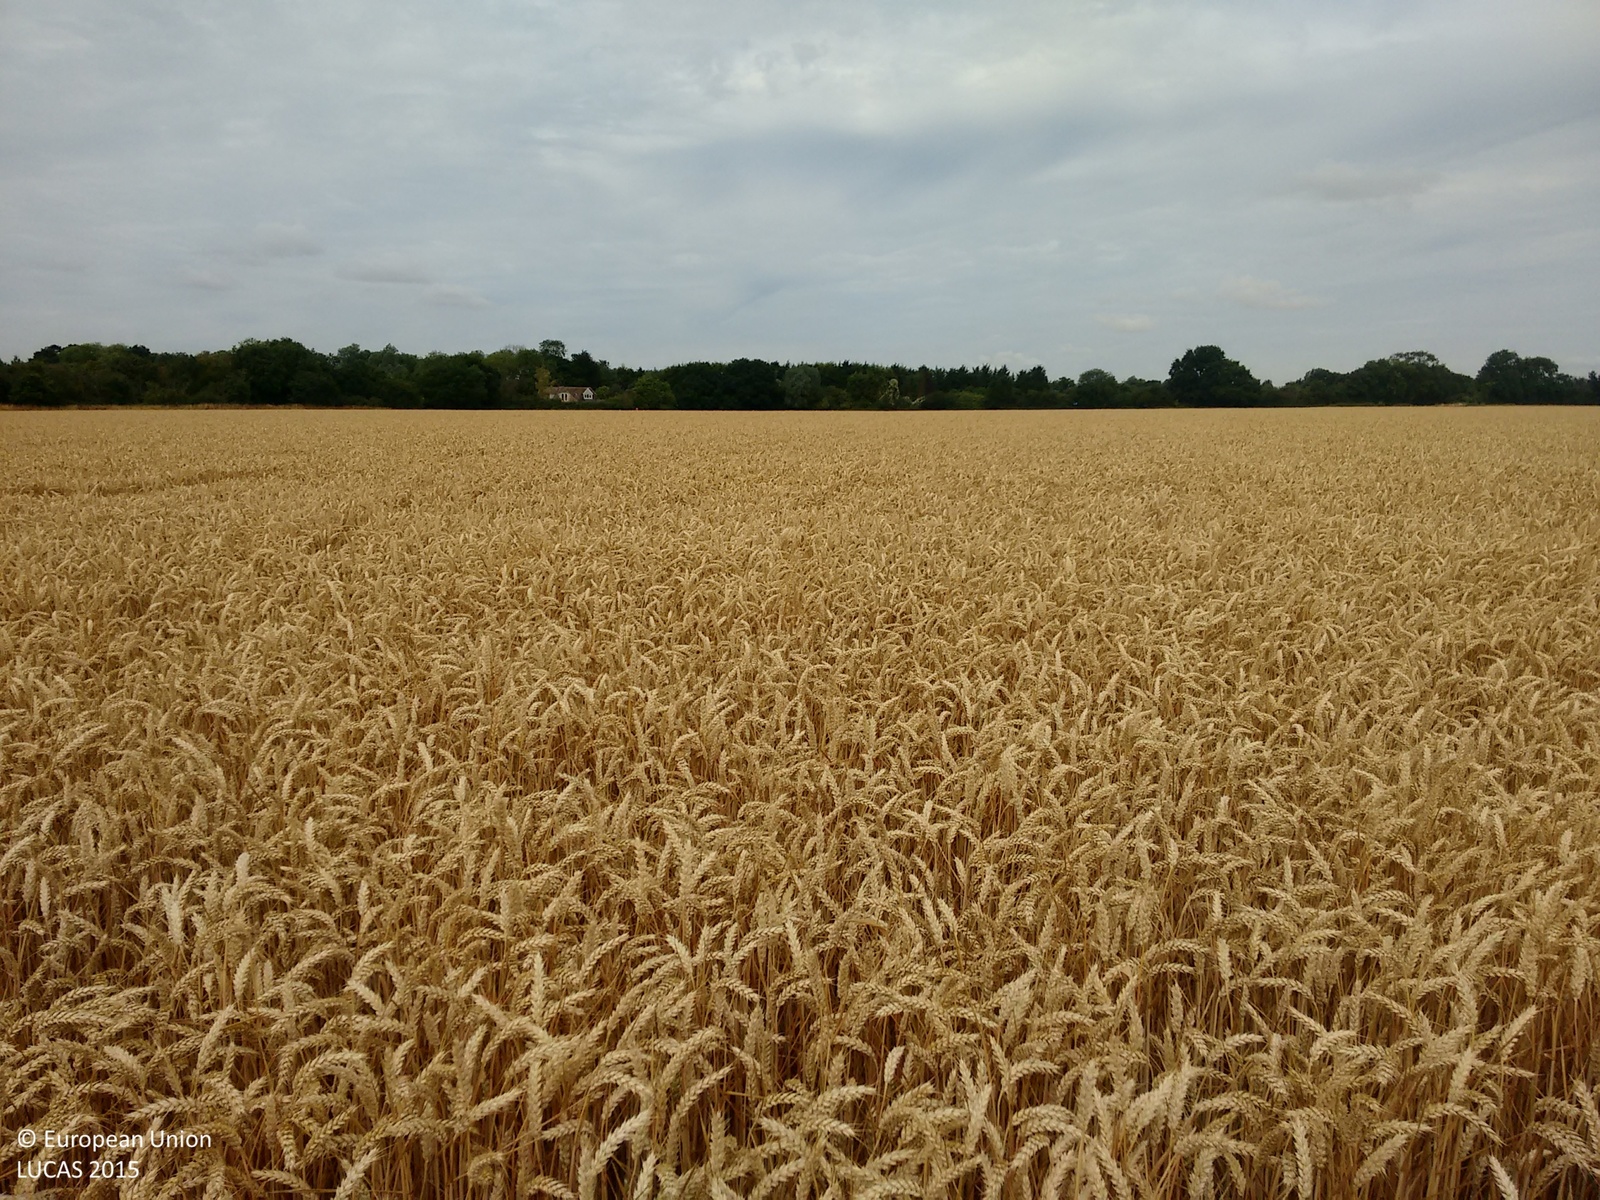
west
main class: Cropland
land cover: Common wheat
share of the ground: > 75 %
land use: Agriculture (excluding fallow land and kitchen gardens)
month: July
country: GB
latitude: 51.7659
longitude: 0.5687
